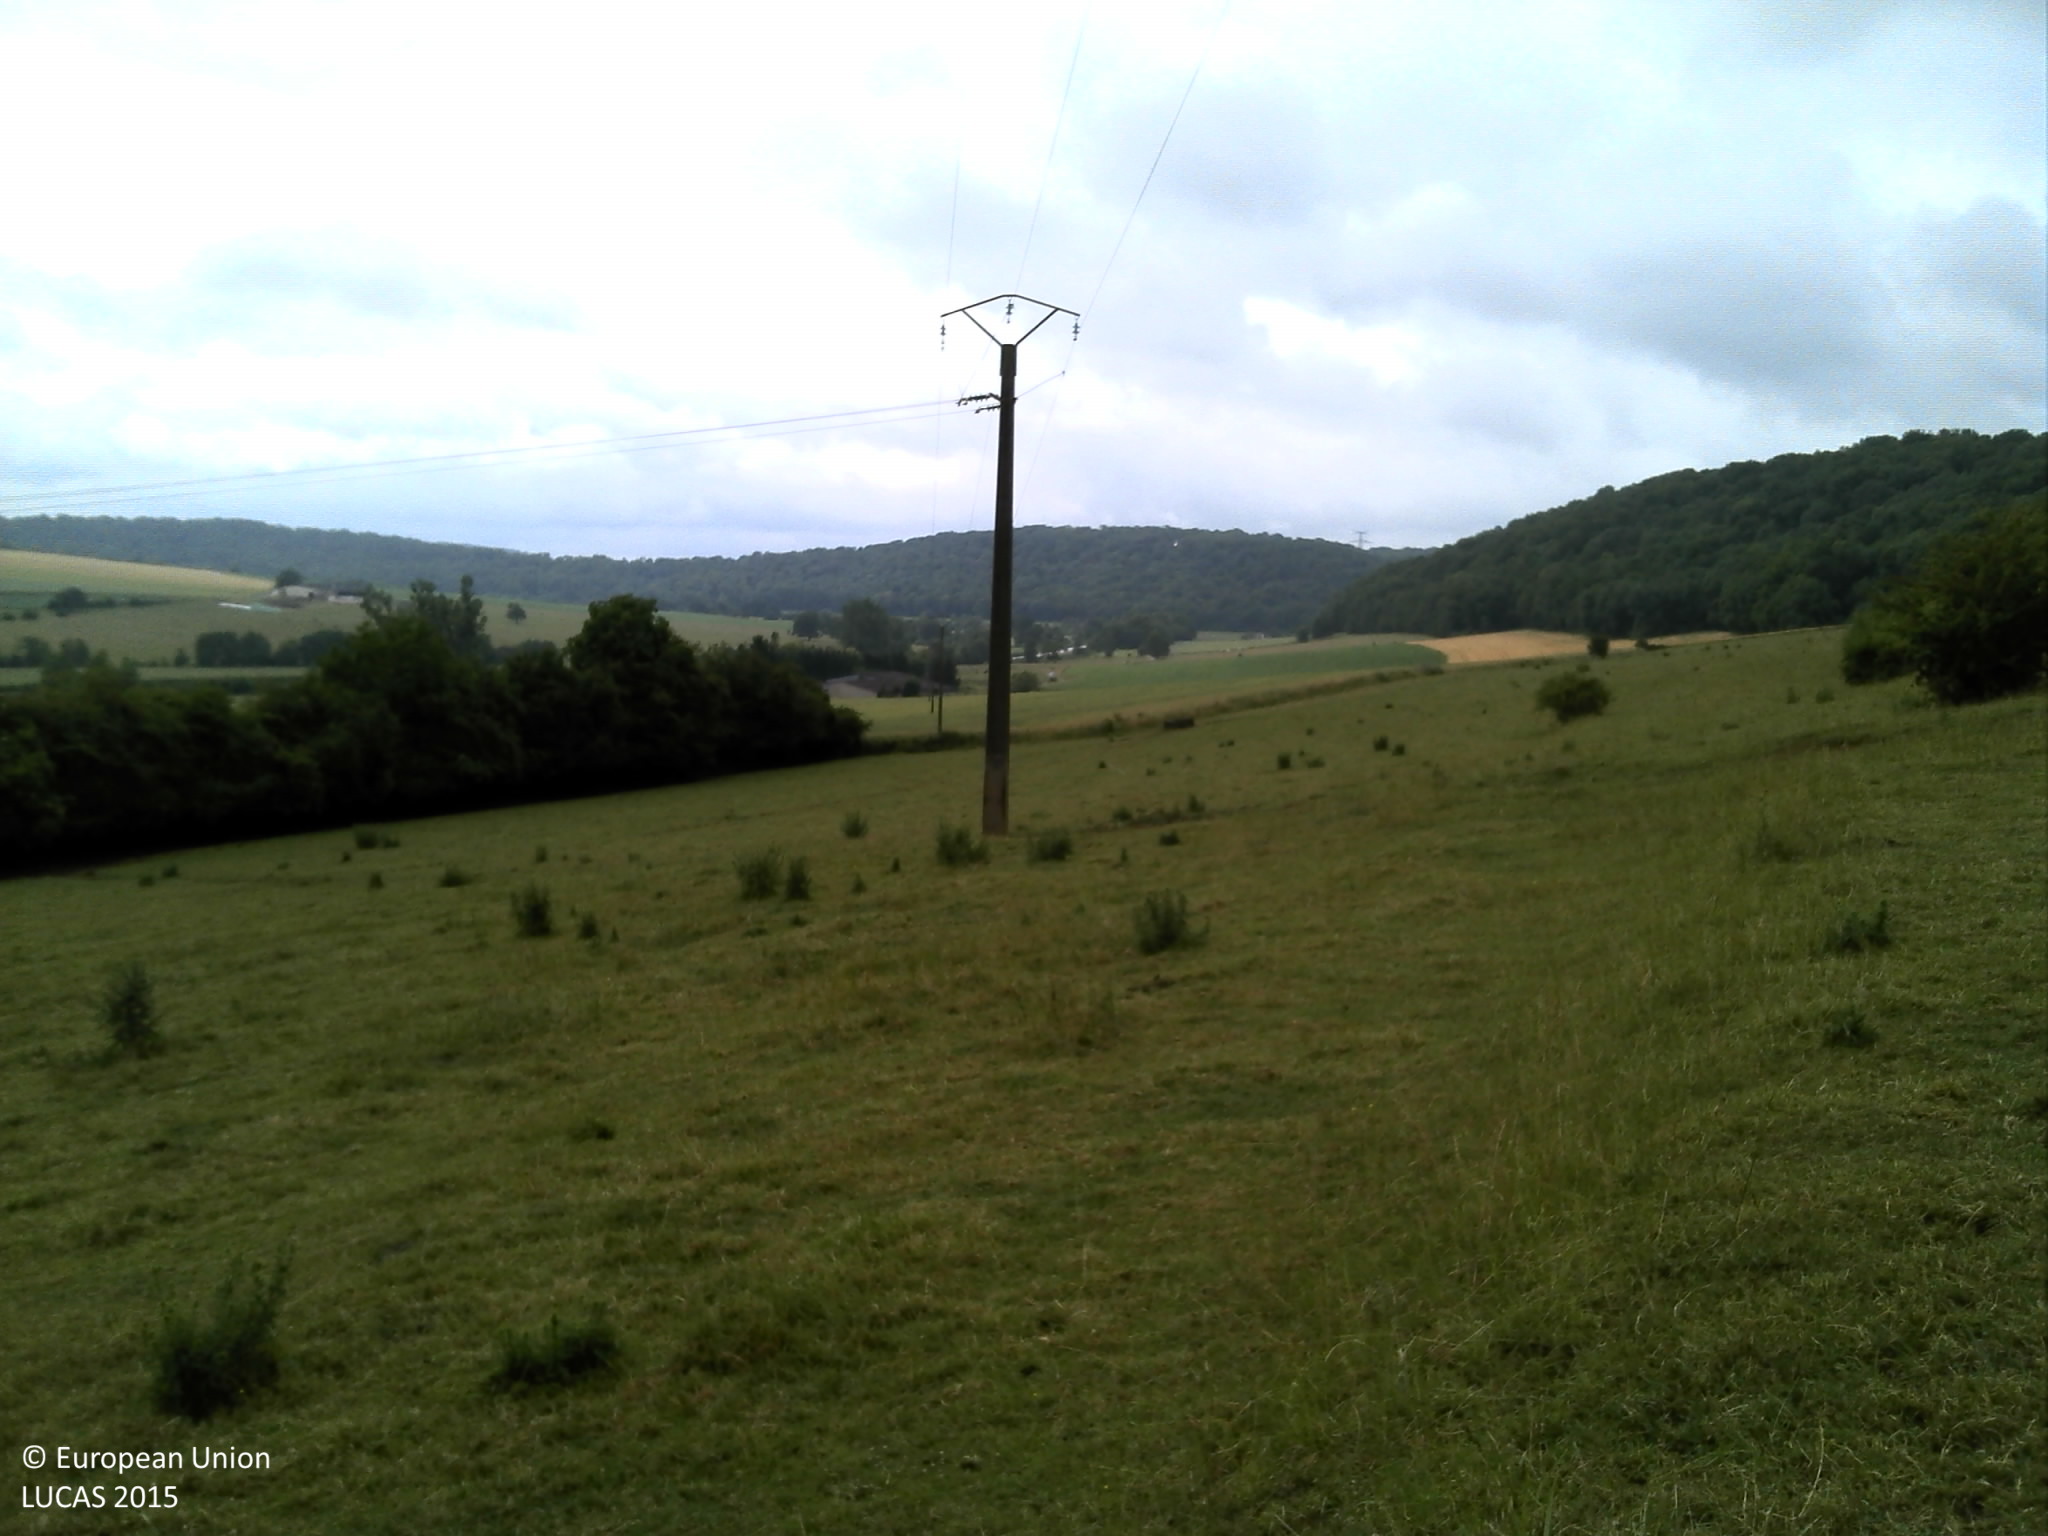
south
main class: Grassland
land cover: Grassland without tree/shrub cover
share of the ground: > 75 %
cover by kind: herbaceous plants 100 %
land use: Agriculture (excluding fallow land and kitchen gardens)
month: June
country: FR
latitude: 49.6705
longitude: 4.8286
